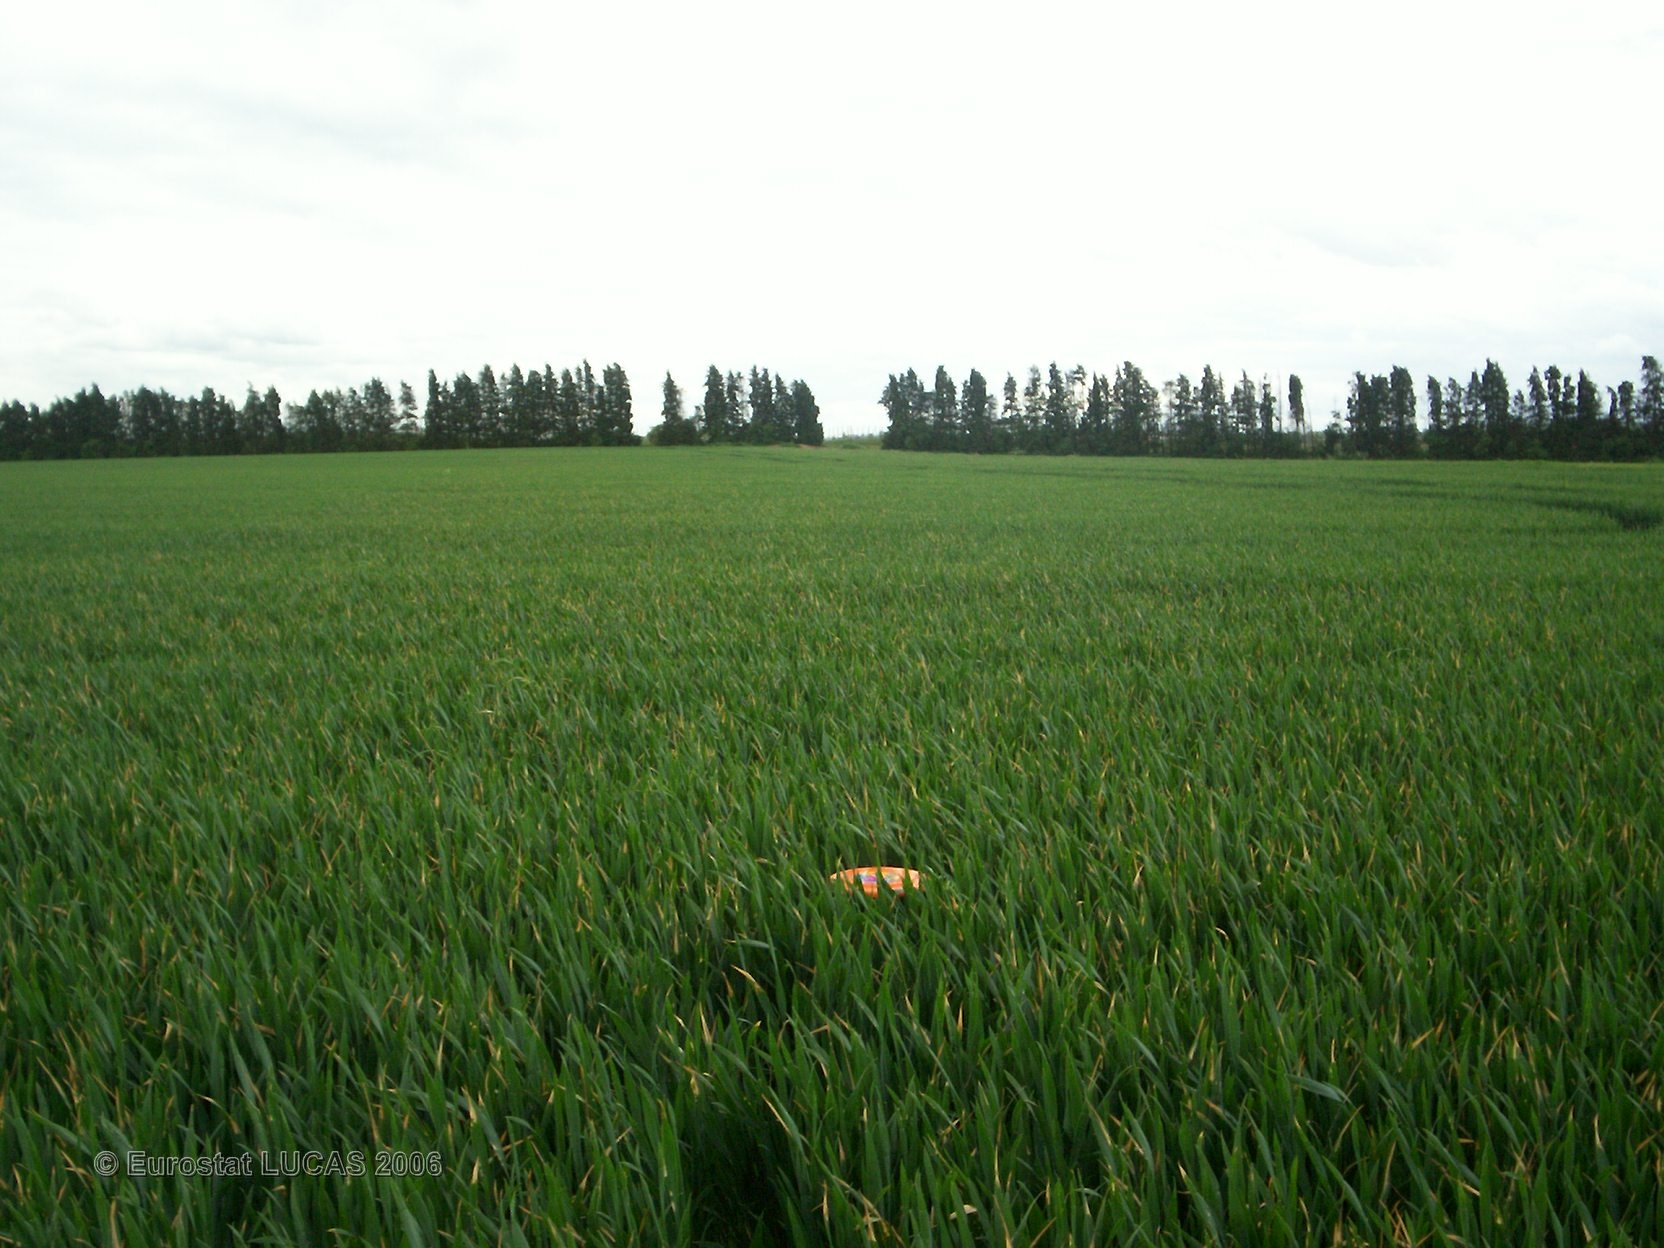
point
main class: Cropland
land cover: Common wheat
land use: Agriculture (excluding fallow land and kitchen gardens)
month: May
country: FR
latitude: 49.0881
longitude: 2.7736
